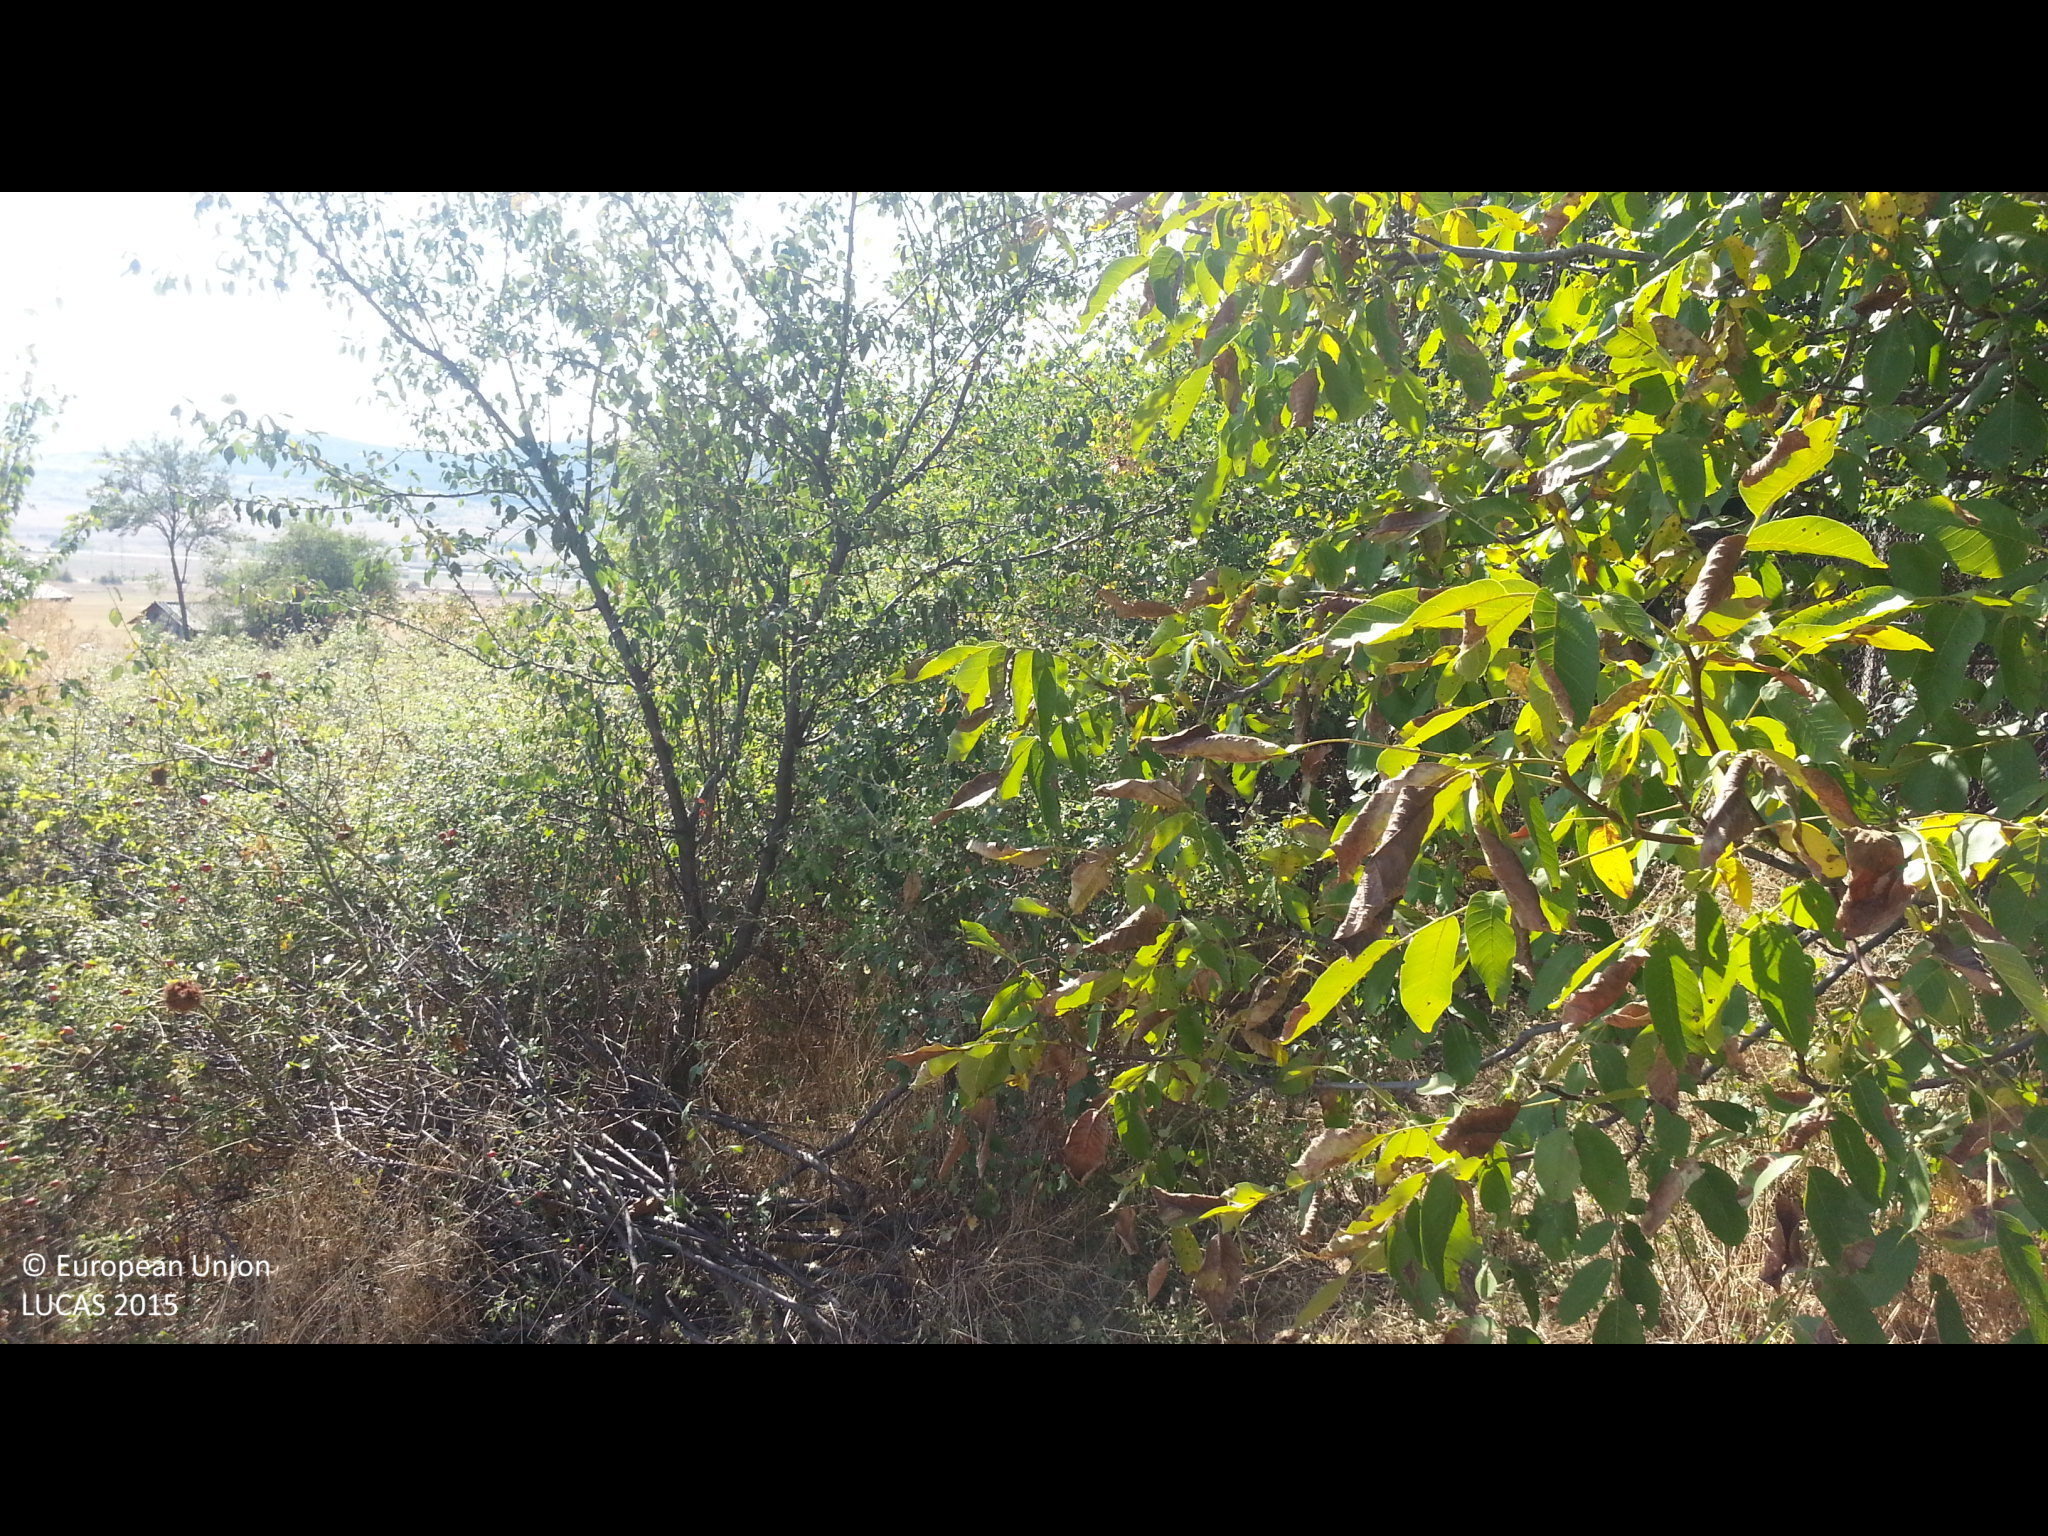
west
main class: Cropland
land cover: Apple fruit
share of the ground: 50 - 75 %
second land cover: Spontaneously vegetated surfaces
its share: > 75 %
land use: Kitchen garden
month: September
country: BG
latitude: 42.4536
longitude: 23.1249
